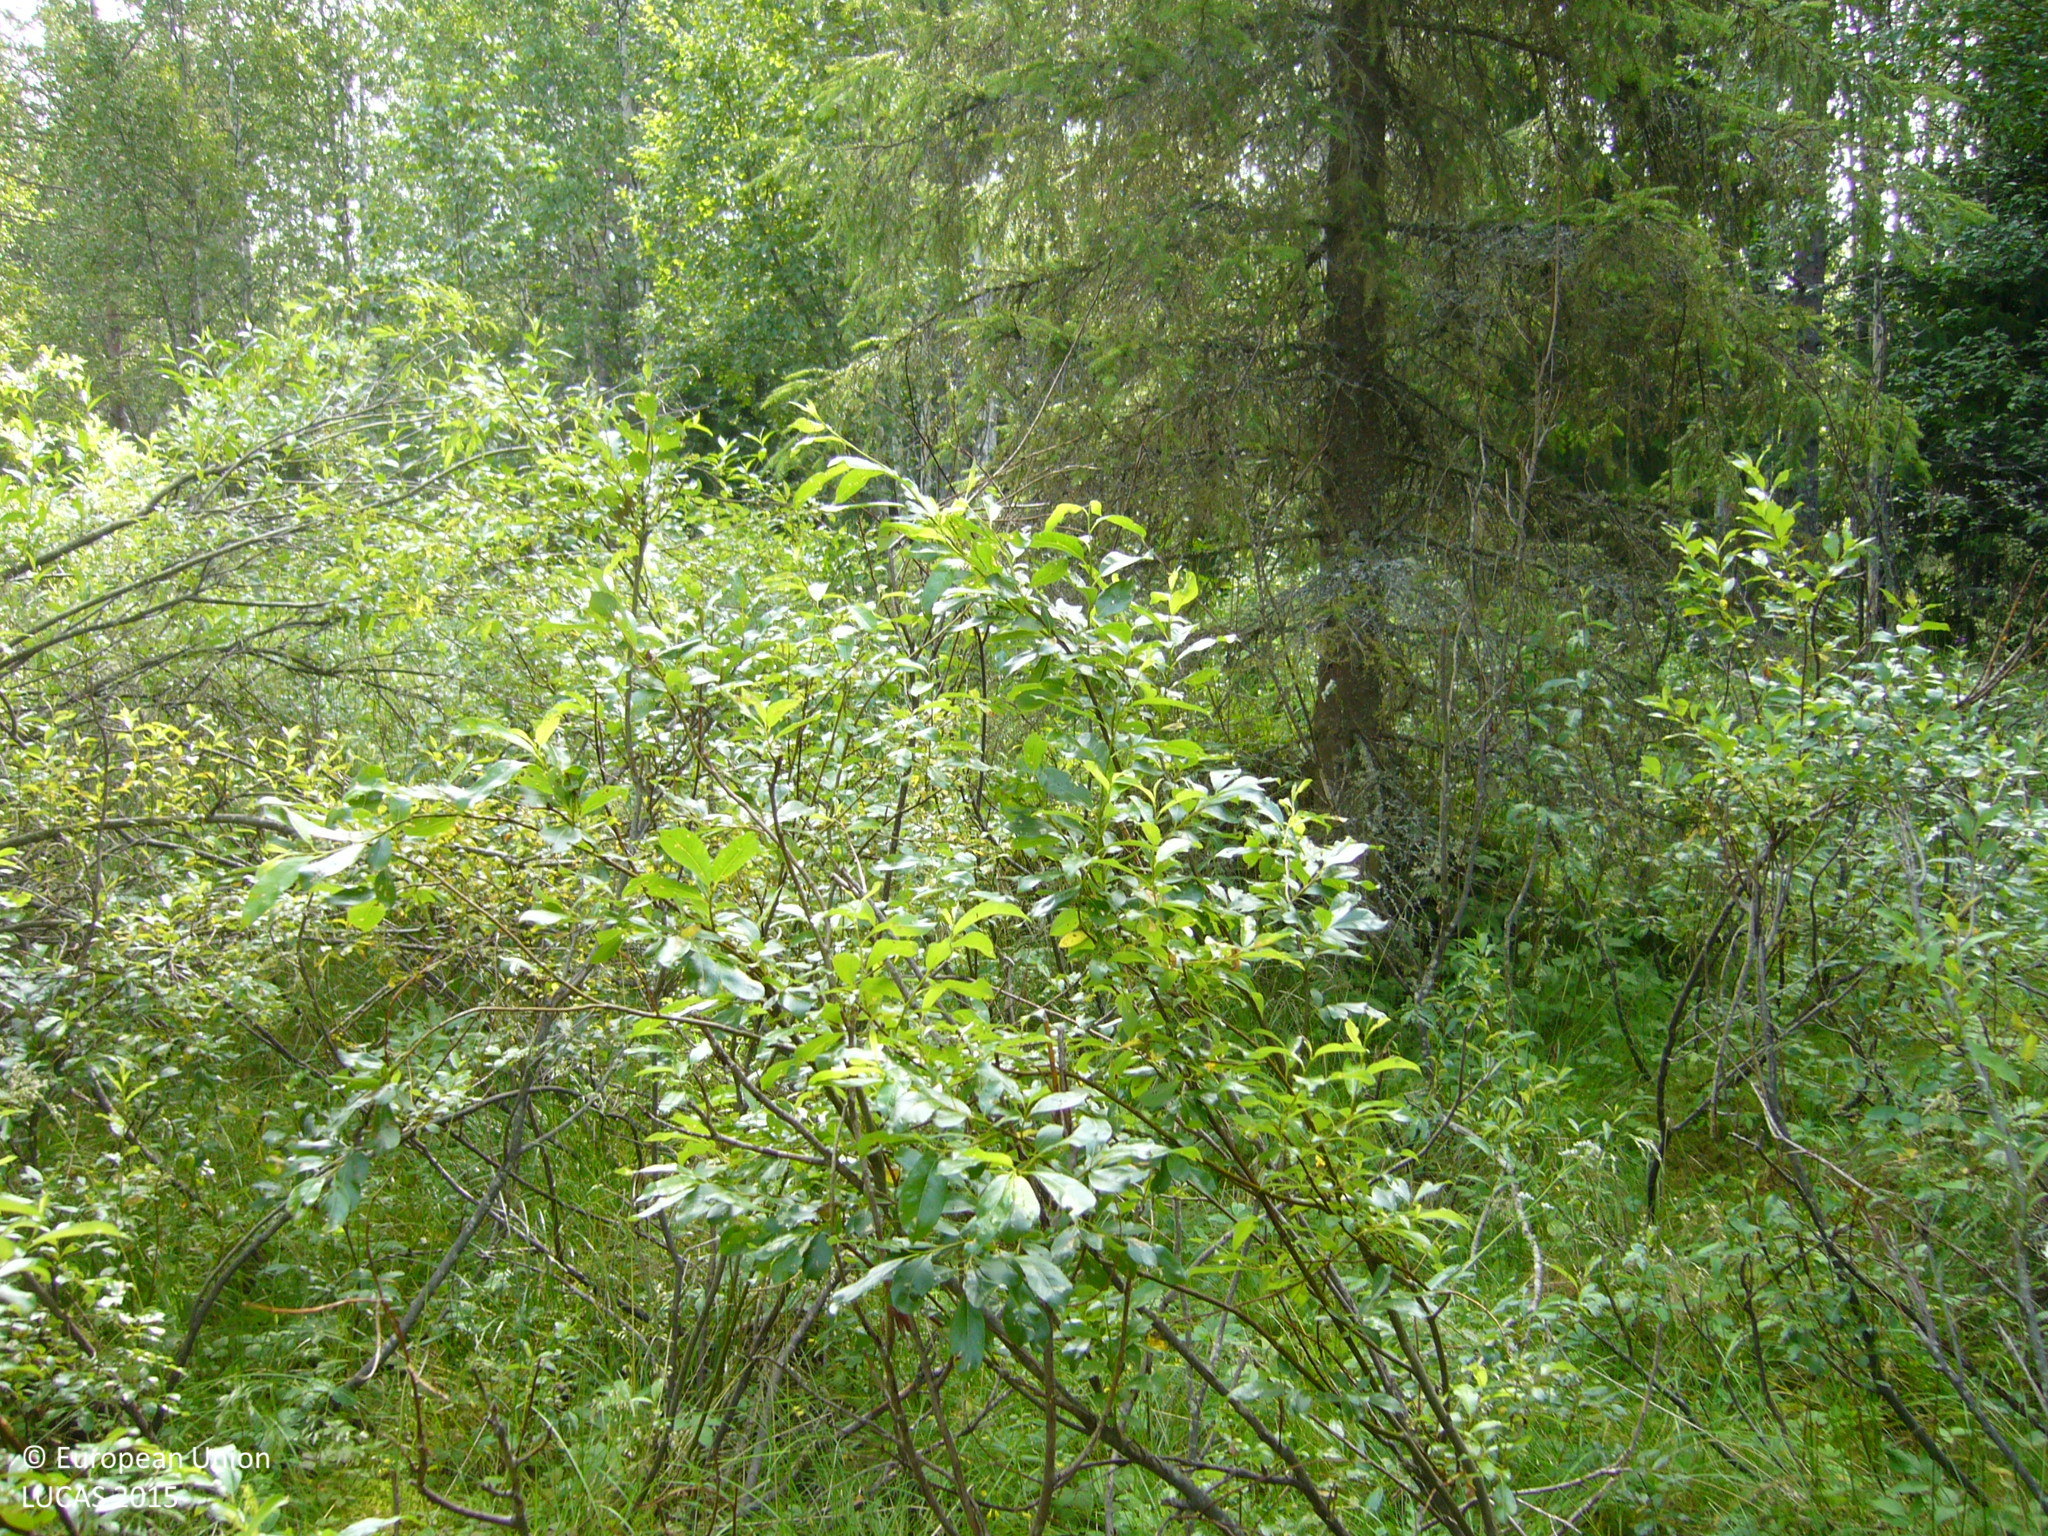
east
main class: Woodland
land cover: Pine dominated mixed woodland
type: boreal forest
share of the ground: 50 - 75 %
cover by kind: broadleaved forest trees 40 %, coniferous forest trees 30 %, herbaceous plants 20 %, shrubs 10 %
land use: Forestry
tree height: > 5 m
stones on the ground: < 10 %
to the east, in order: Pine dominated mixed woodland; Ditches and canals; Pine dominated mixed woodland; Ditches and canals; Pine dominated mixed woodland; Inland marshes; Pine dominated mixed woodland
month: July
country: FI
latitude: 63.9355
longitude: 26.1248
